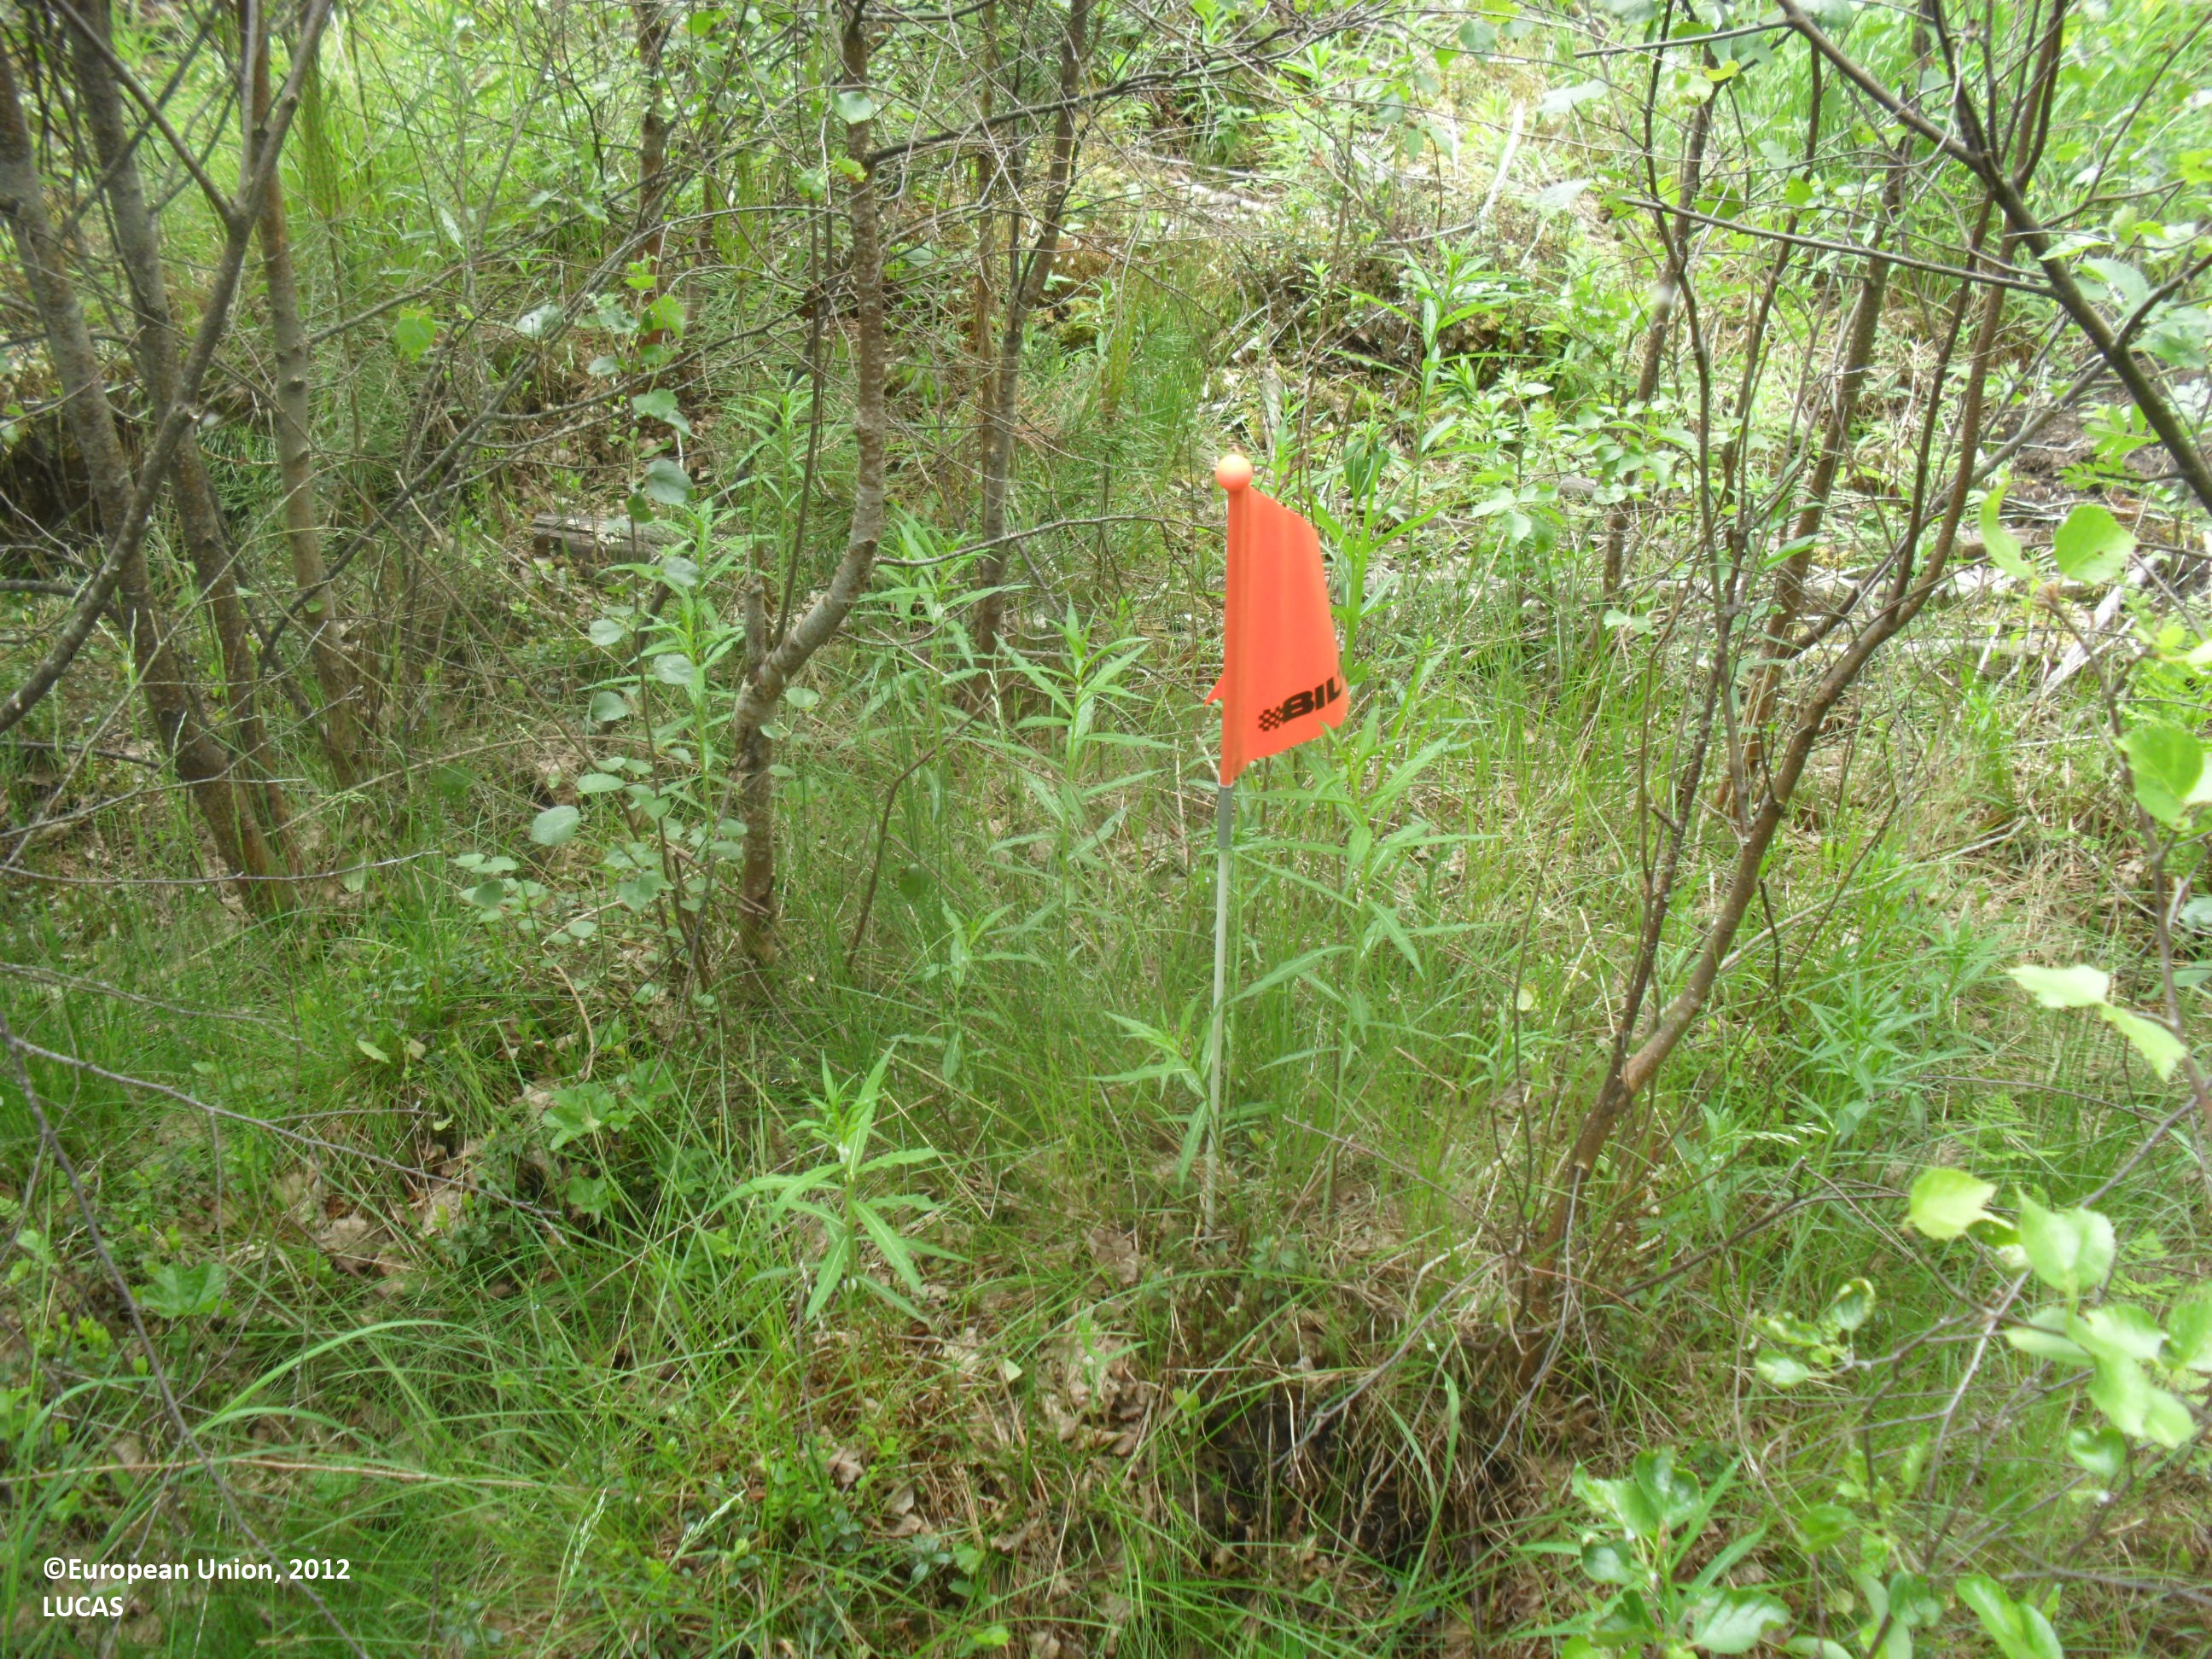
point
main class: Woodland
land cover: Other mixed woodland
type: boreal forest
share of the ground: 50 - 75 %
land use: Forestry
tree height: < 5 m
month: June
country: FI
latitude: 63.4594
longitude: 23.4002
